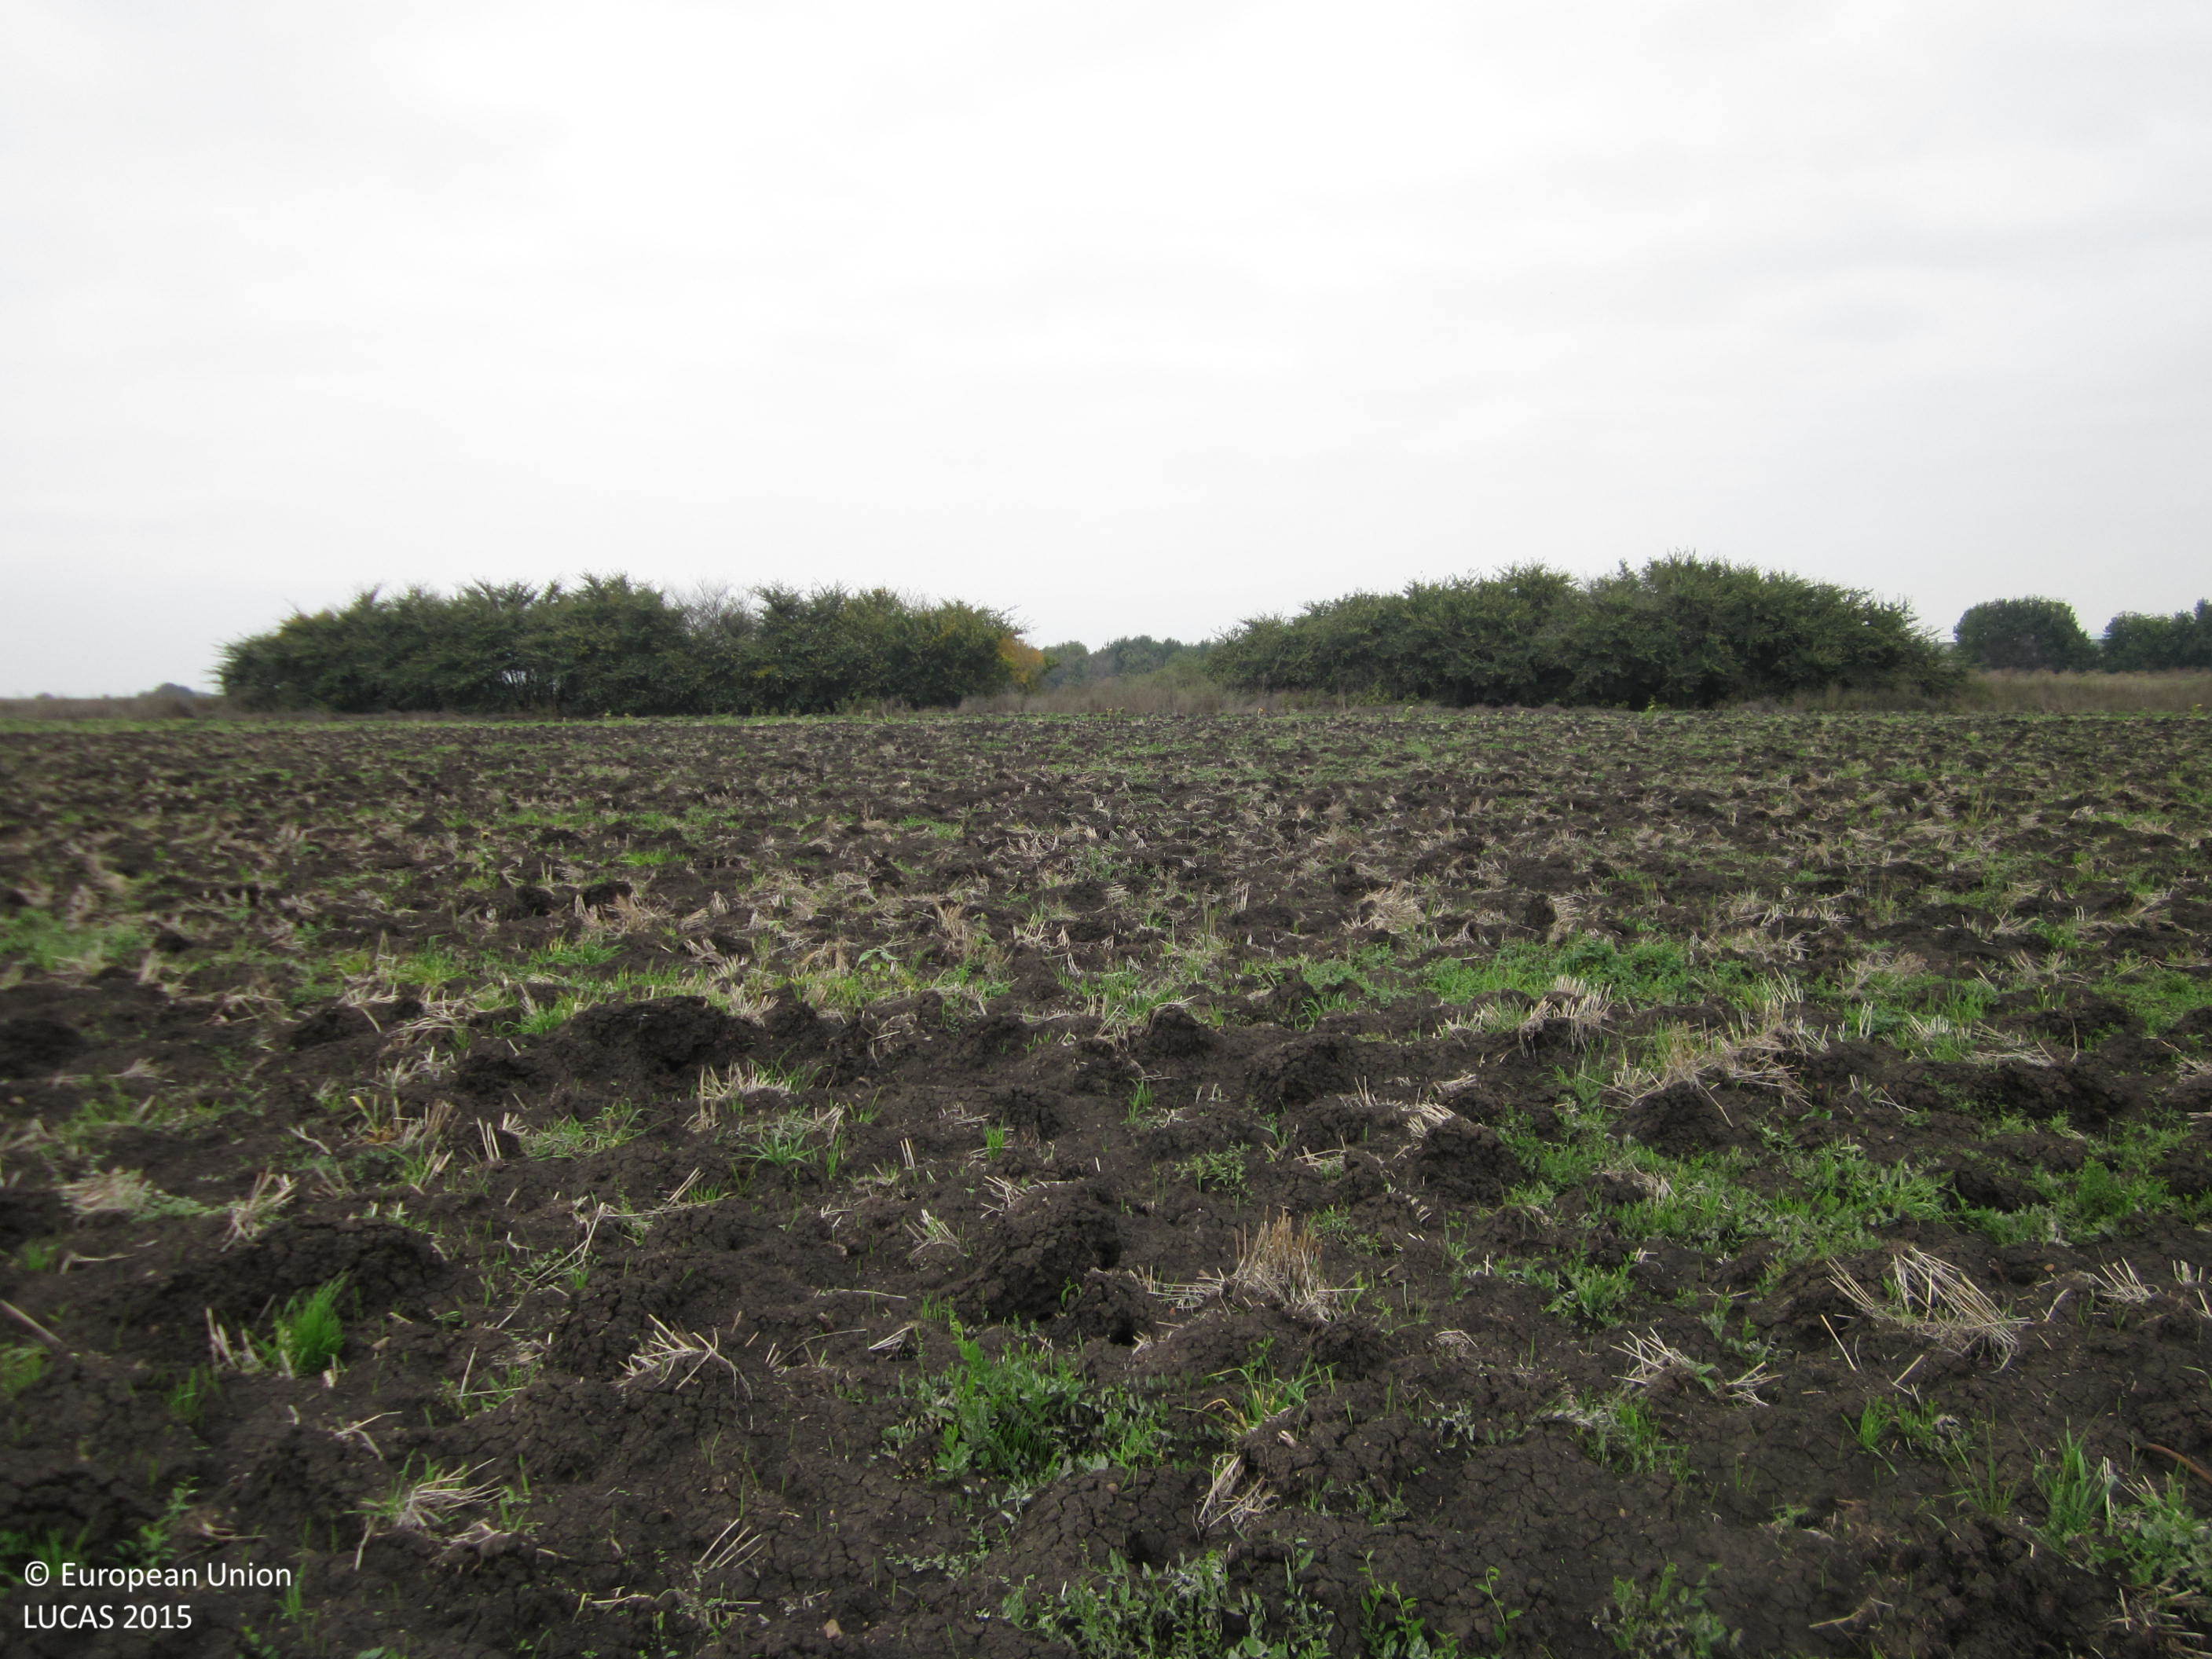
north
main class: Cropland
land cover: Barley
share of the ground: < 10 %
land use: Agriculture (excluding fallow land and kitchen gardens)
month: October
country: BG
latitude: 42.5476
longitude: 27.2208
